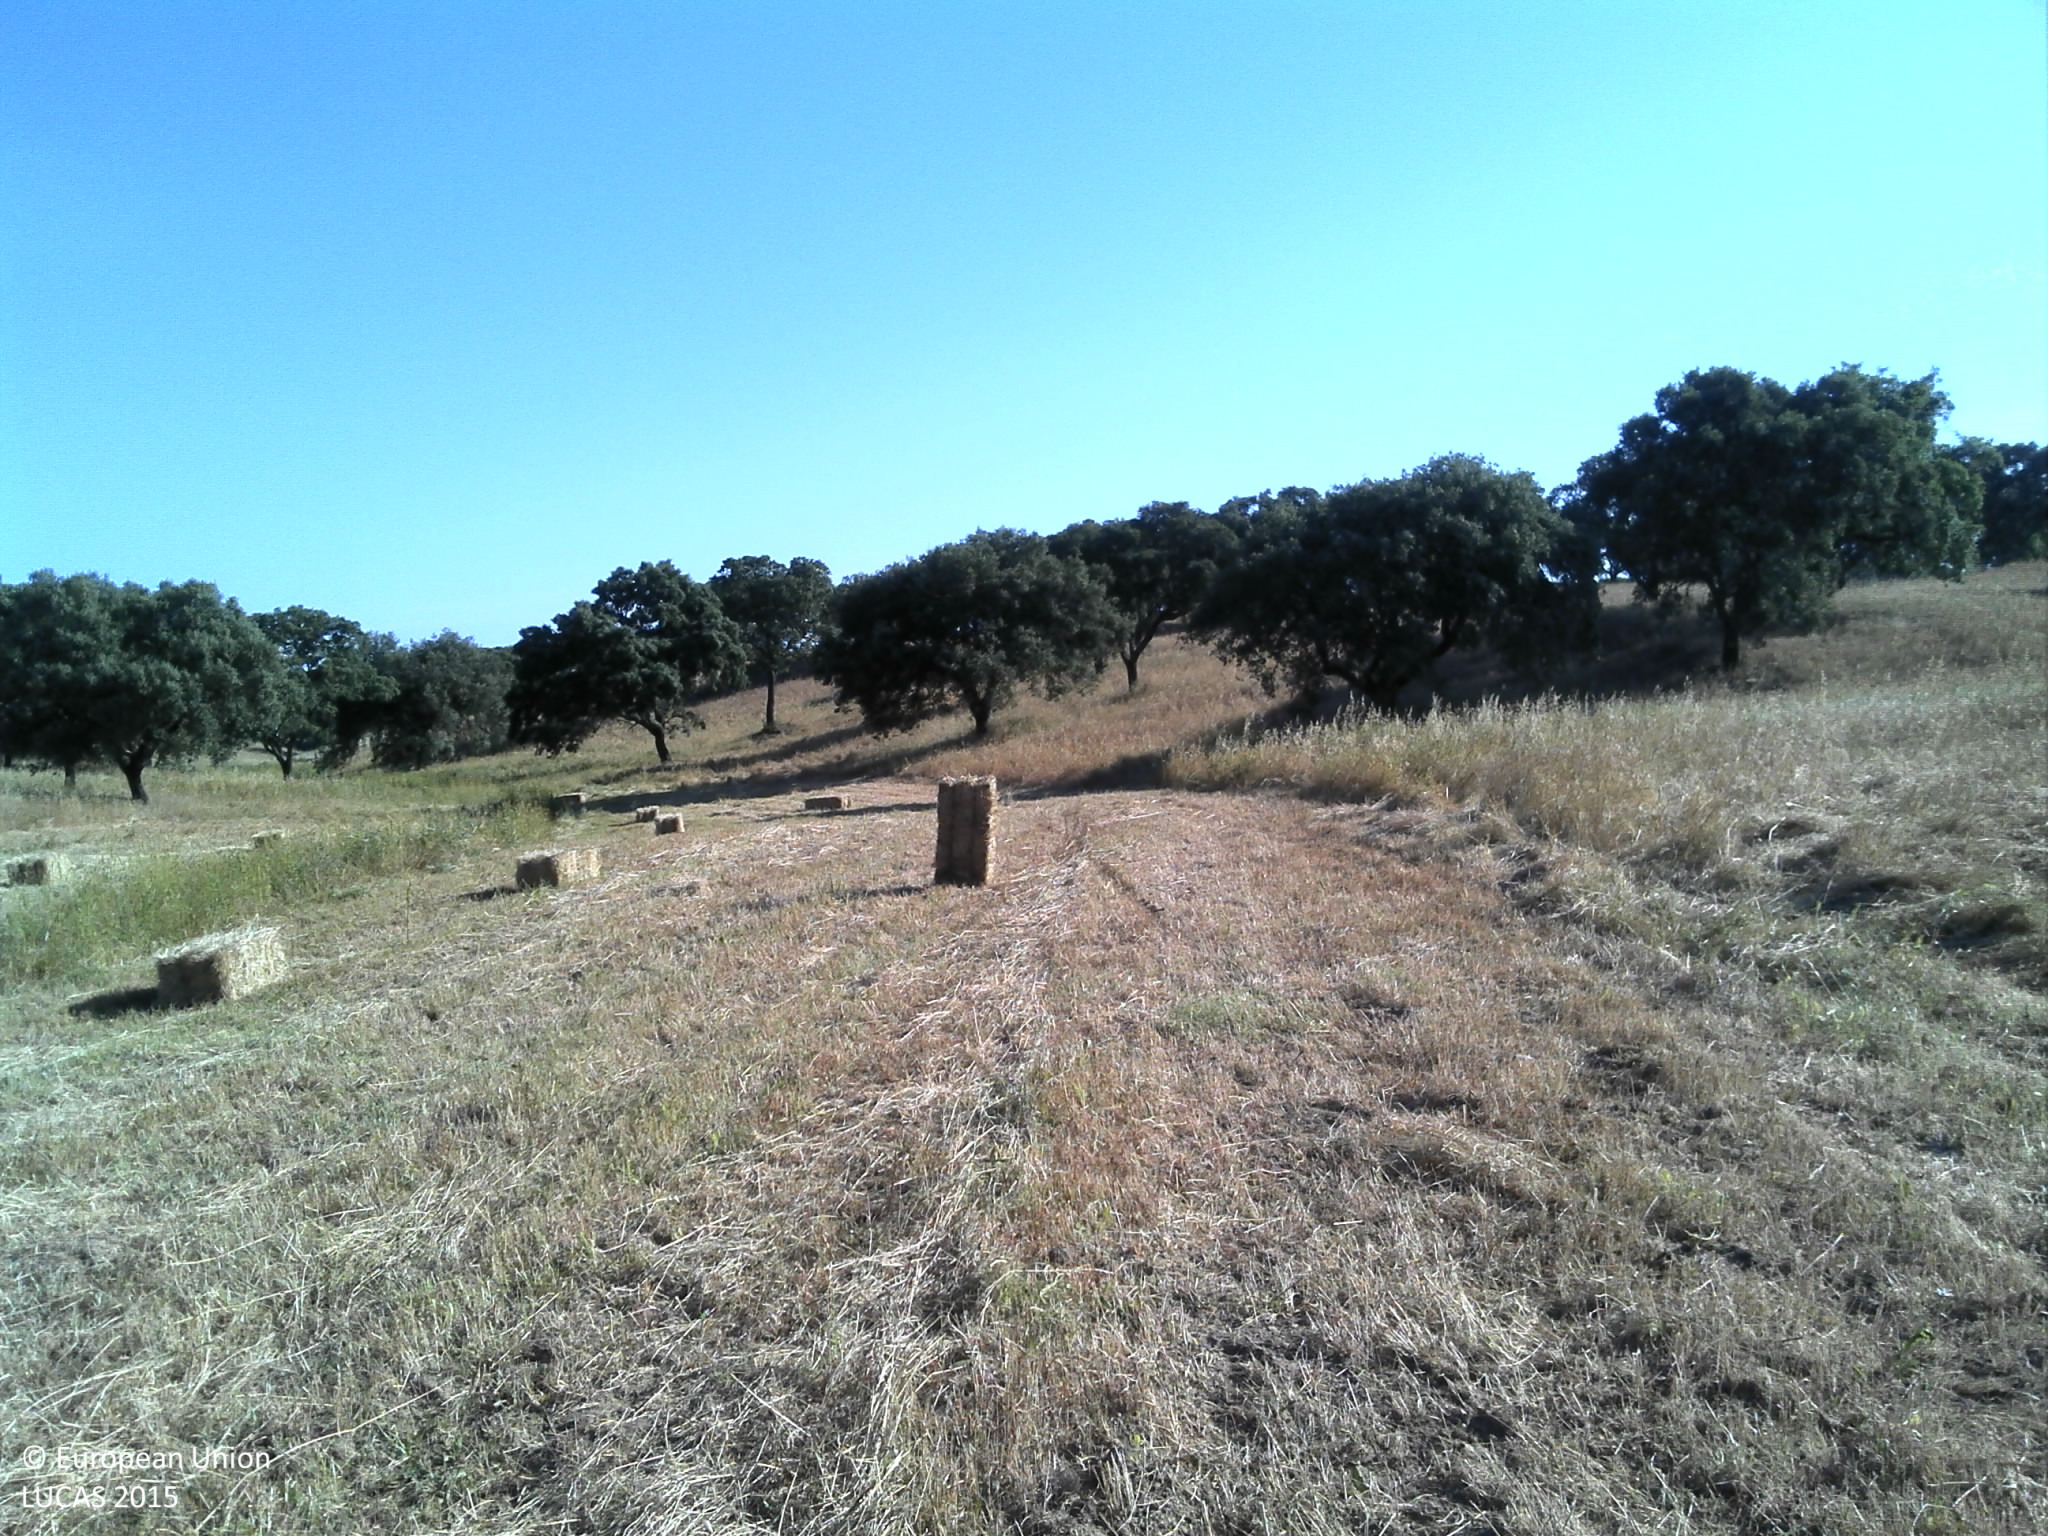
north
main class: Cropland
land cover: Other leguminous and mixtures for fodder
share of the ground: 50 - 75 %
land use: Agriculture (excluding fallow land and kitchen gardens)
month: May
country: PT
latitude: 38.1001
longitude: -8.4139
